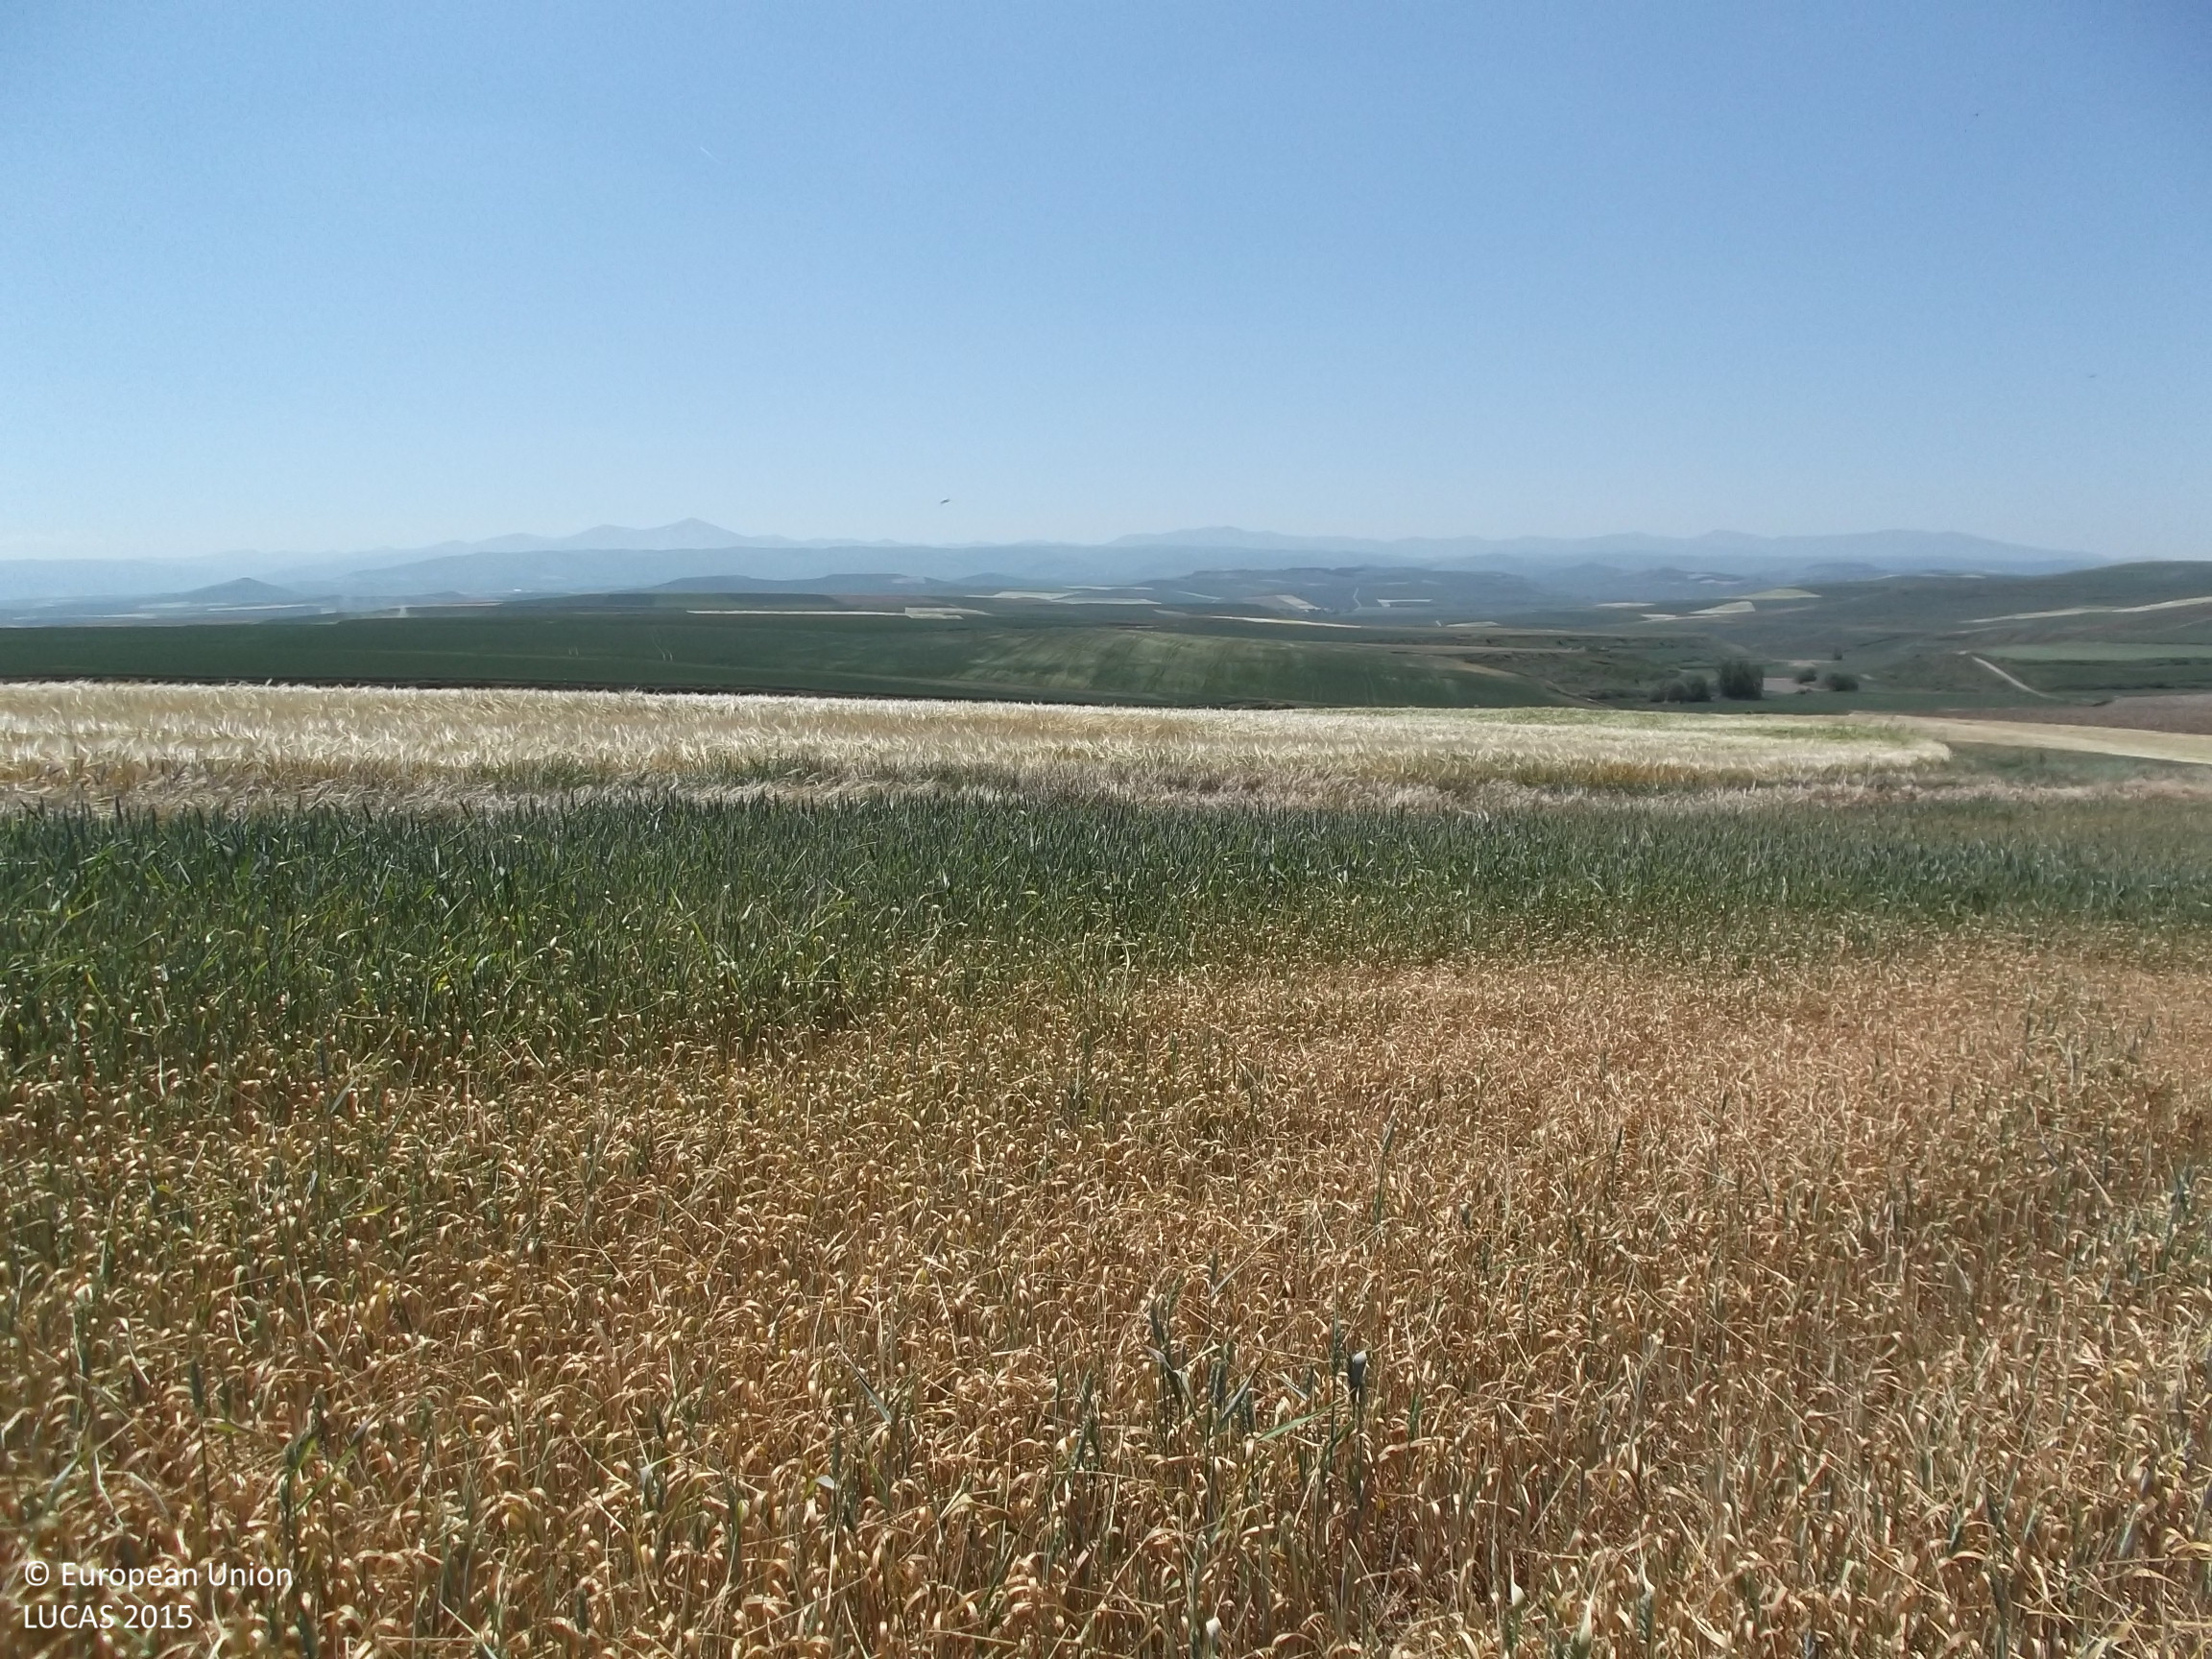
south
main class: Cropland
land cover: Common wheat
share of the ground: > 75 %
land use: Agriculture (excluding fallow land and kitchen gardens)
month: May
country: ES
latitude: 42.5340
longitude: -3.0687
